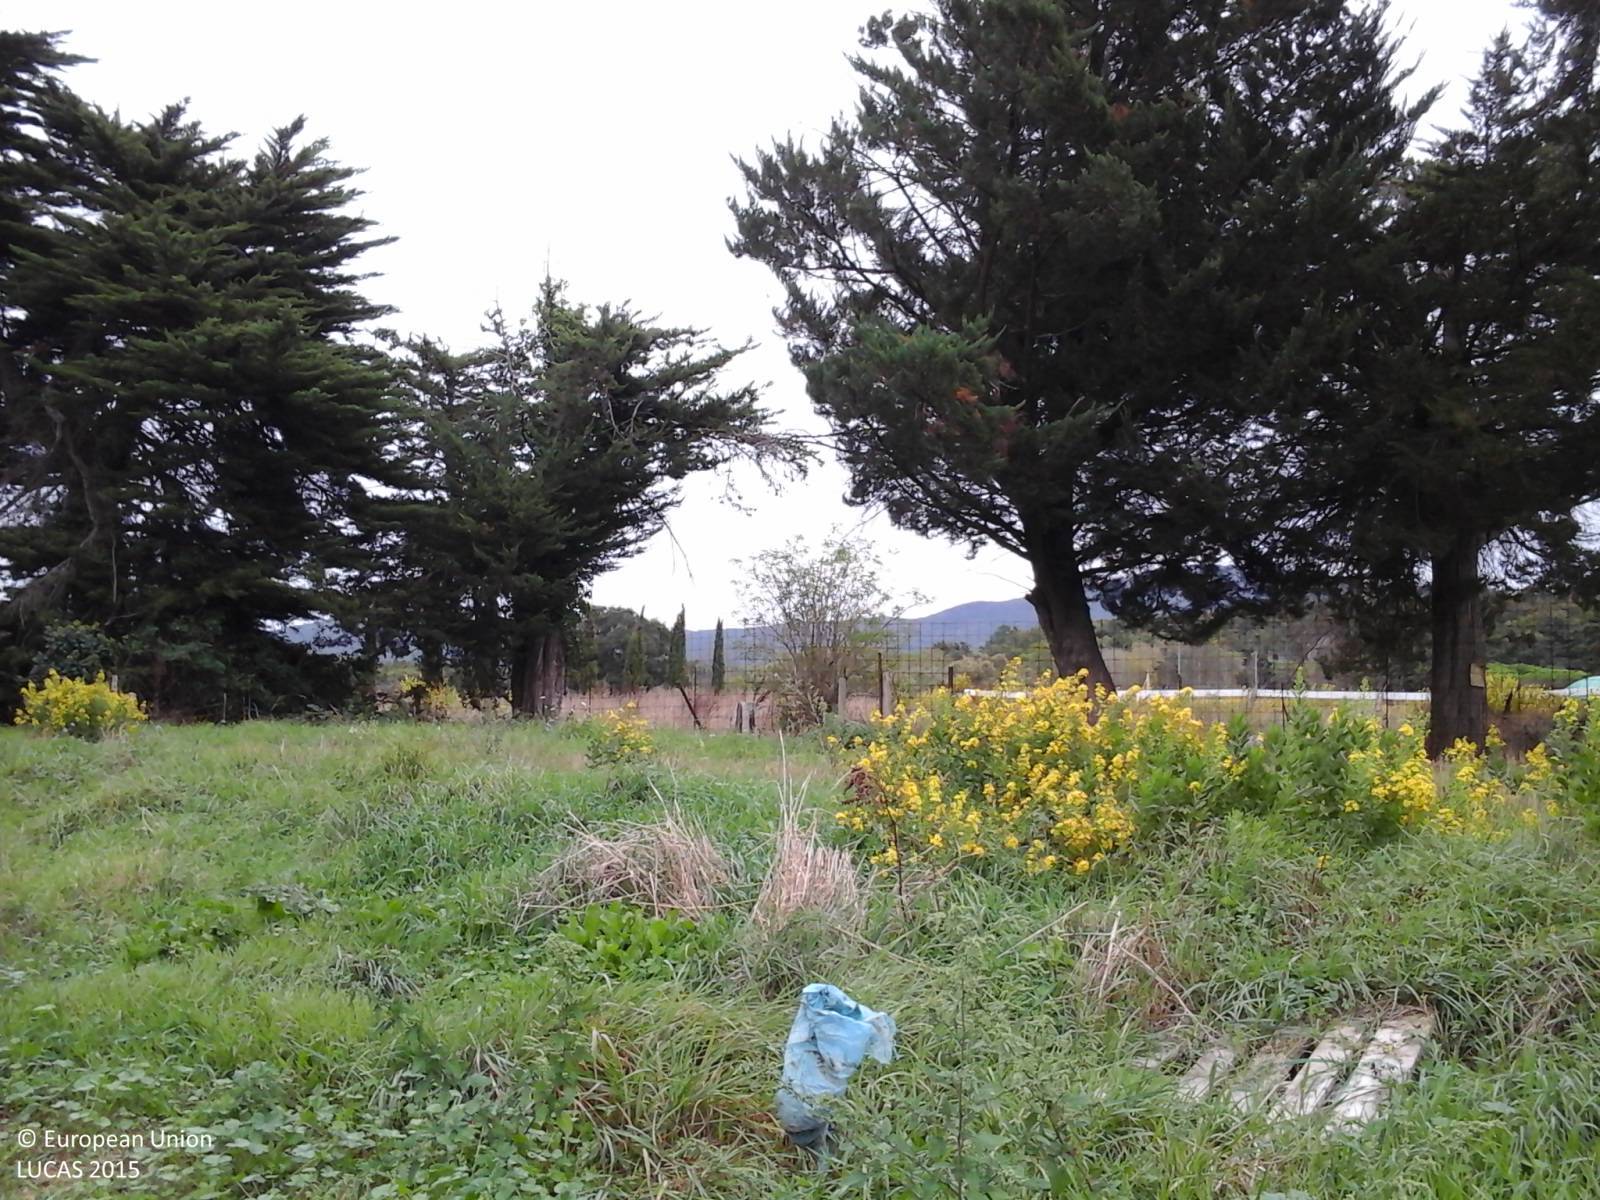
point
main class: Grassland
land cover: Spontaneously vegetated surfaces
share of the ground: 50 - 75 %
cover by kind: herbaceous plants 100 %
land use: Construction
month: October
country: IT
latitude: 43.5561
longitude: 10.3580
